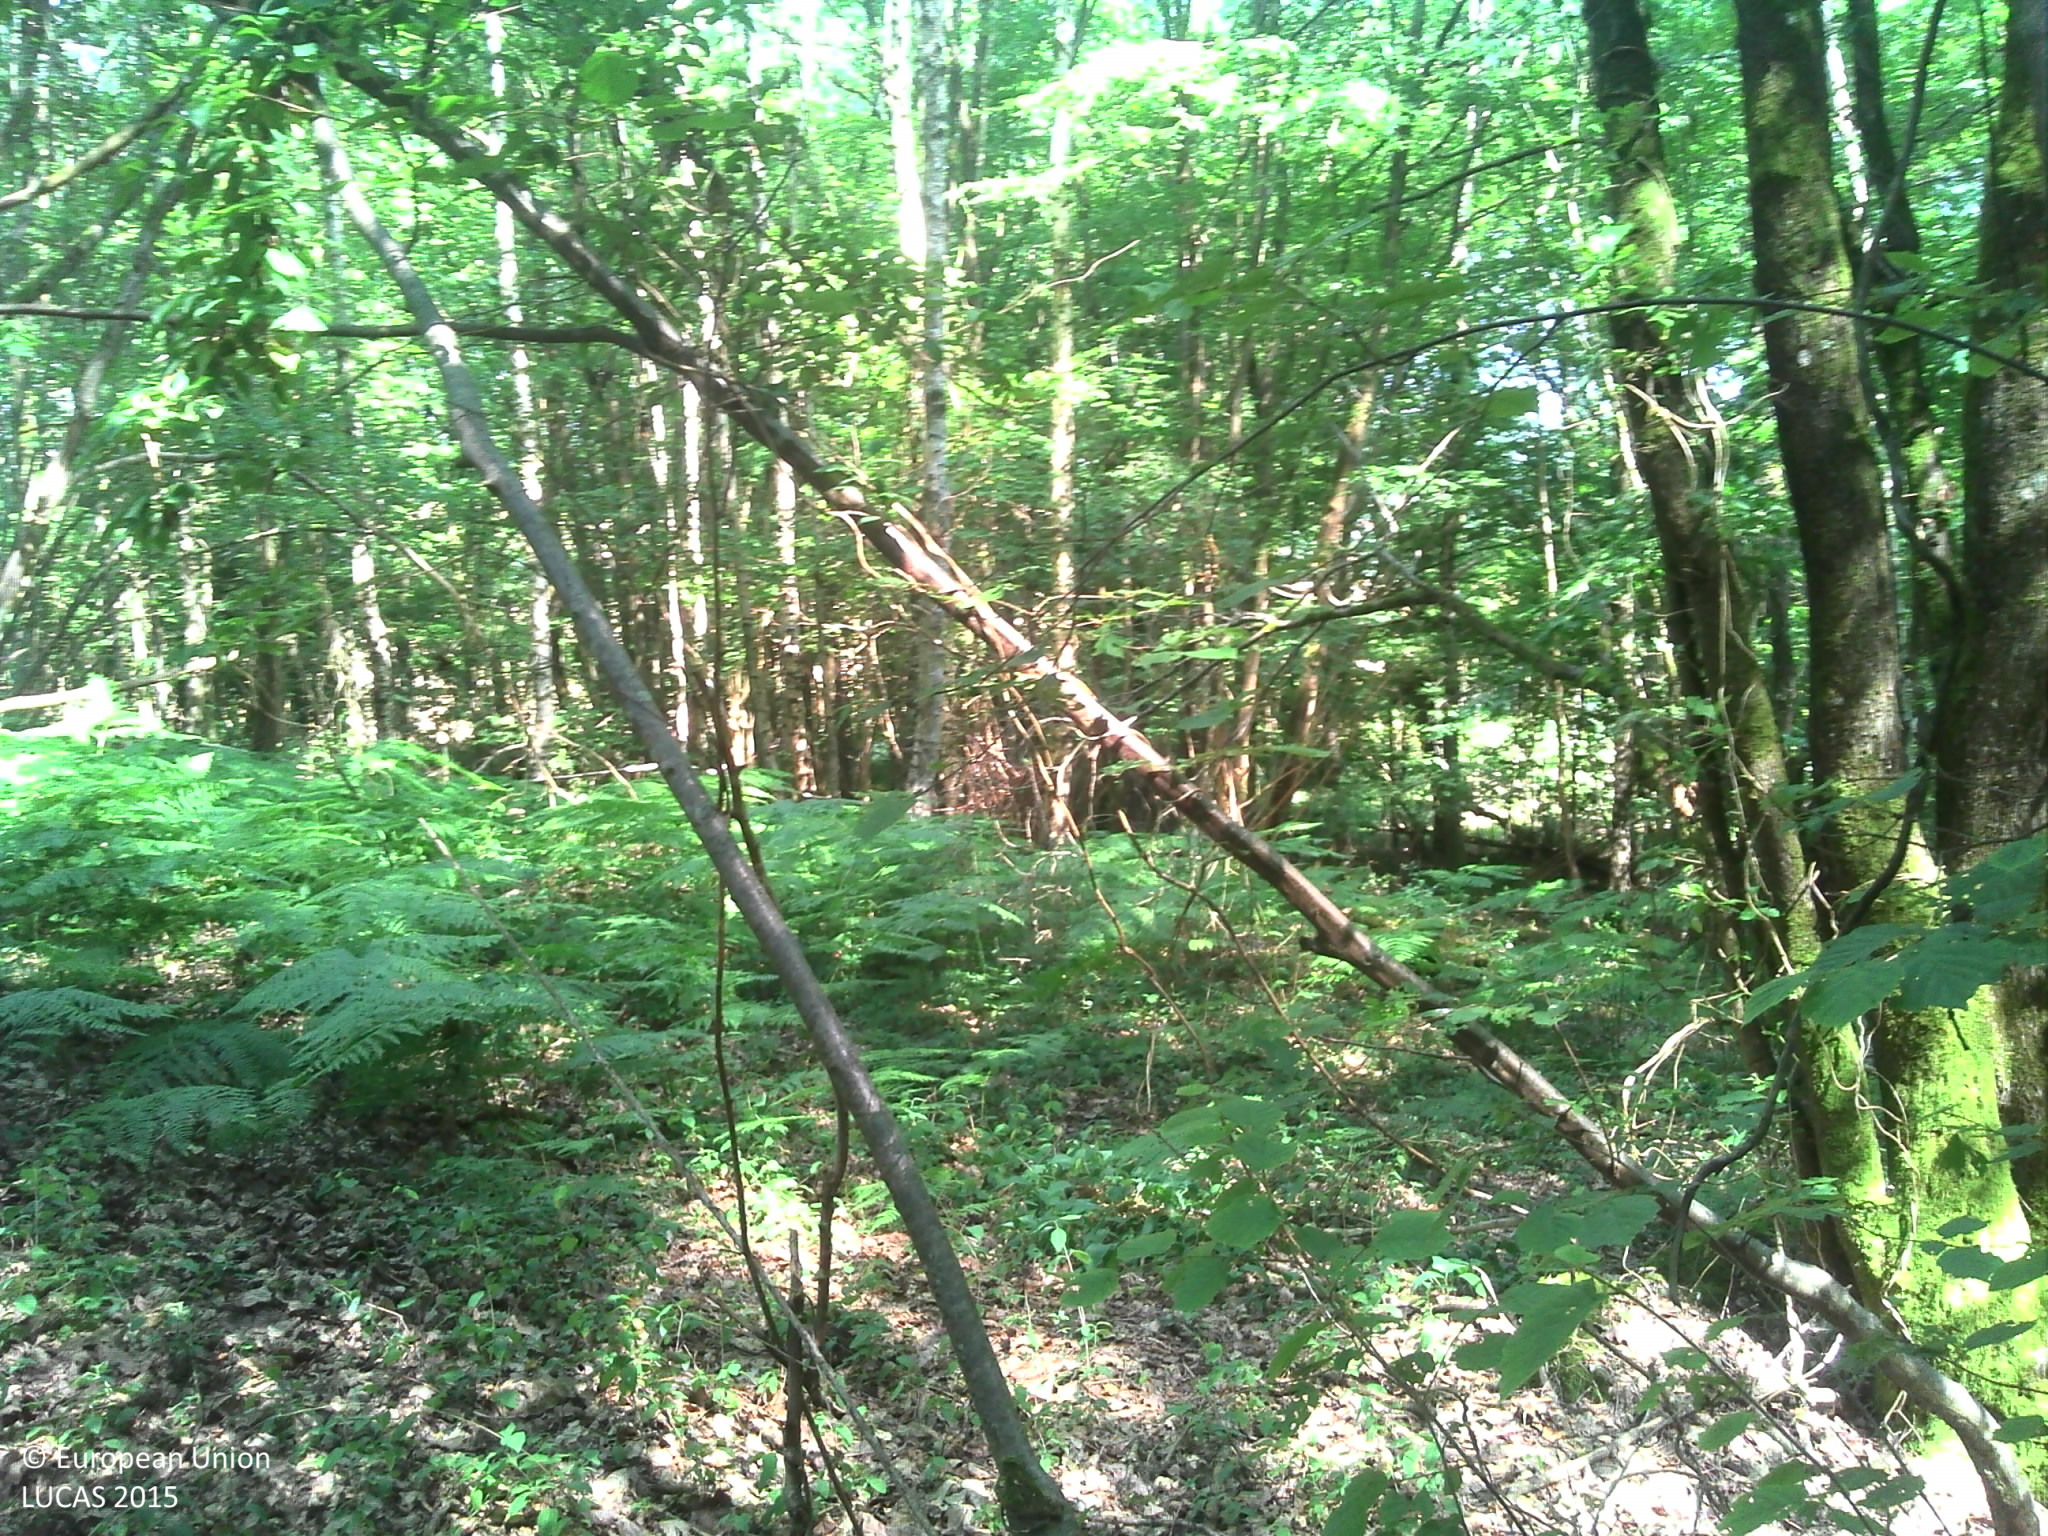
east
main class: Woodland
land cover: Broadleaved woodland
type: mesophytic deciduous forest
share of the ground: > 75 %
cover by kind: broadleaved forest trees 90 %, herbaceous plants 5 %, unconsolidated bare surface 5 %
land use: Forestry
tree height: > 5 m
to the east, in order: Broadleaved woodland; Common wheat
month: July
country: FR
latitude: 49.0667
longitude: 3.2994
